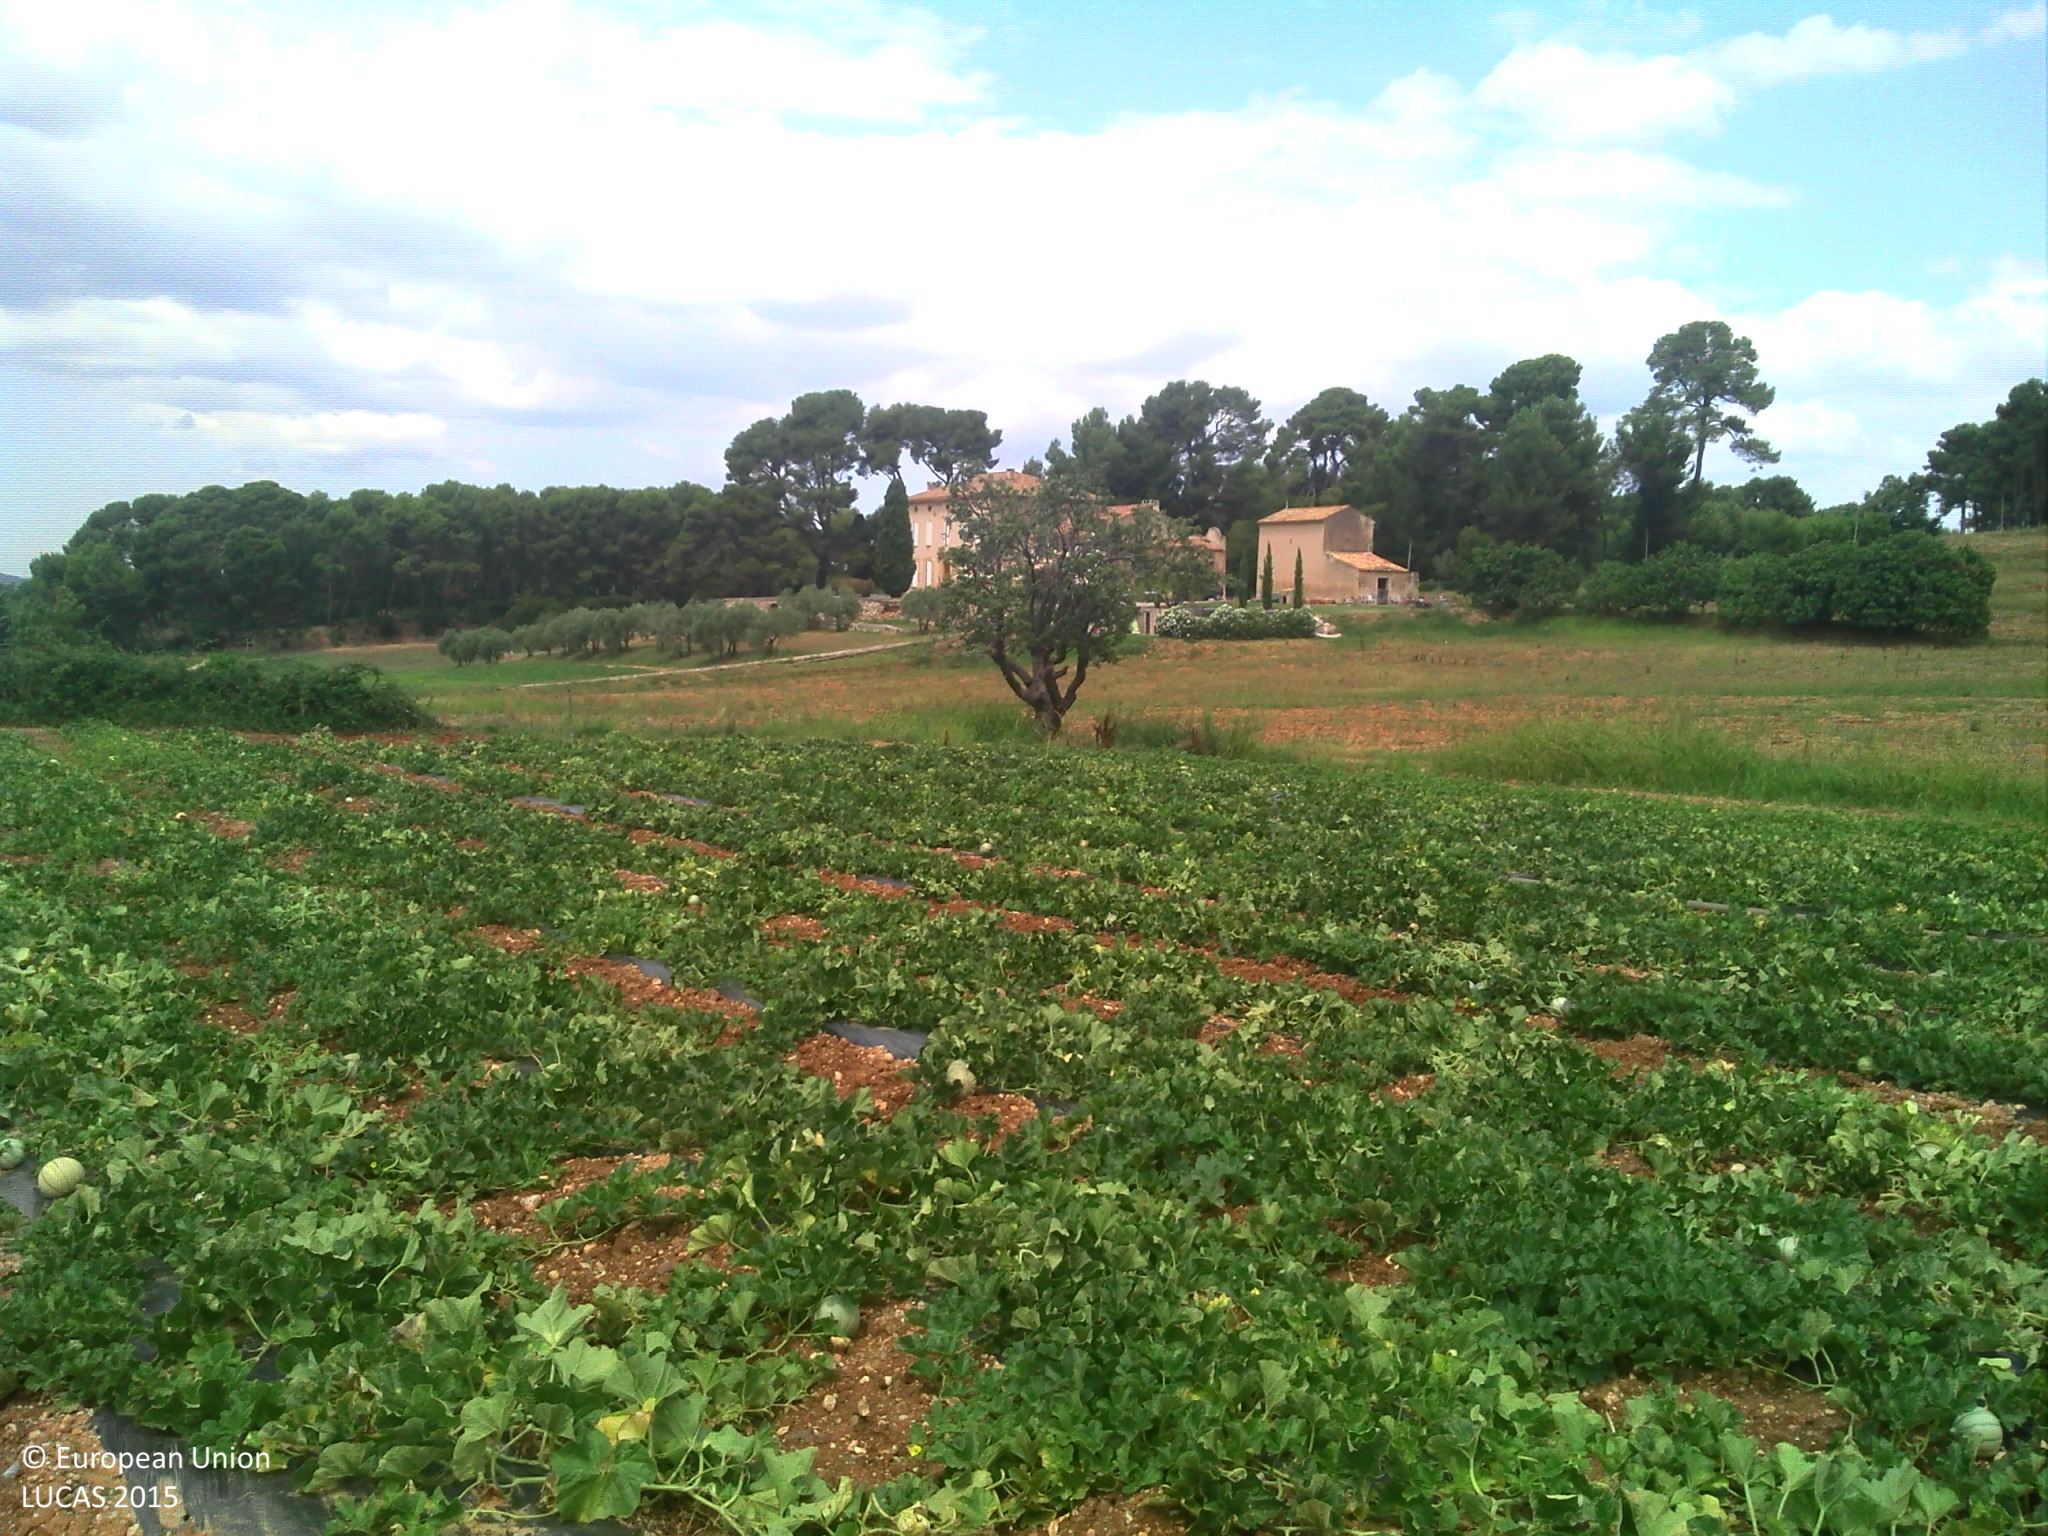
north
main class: Cropland
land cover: Other fresh vegetables
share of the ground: > 75 %
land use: Agriculture (excluding fallow land and kitchen gardens)
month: August
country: FR
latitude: 43.4896
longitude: 5.3975
